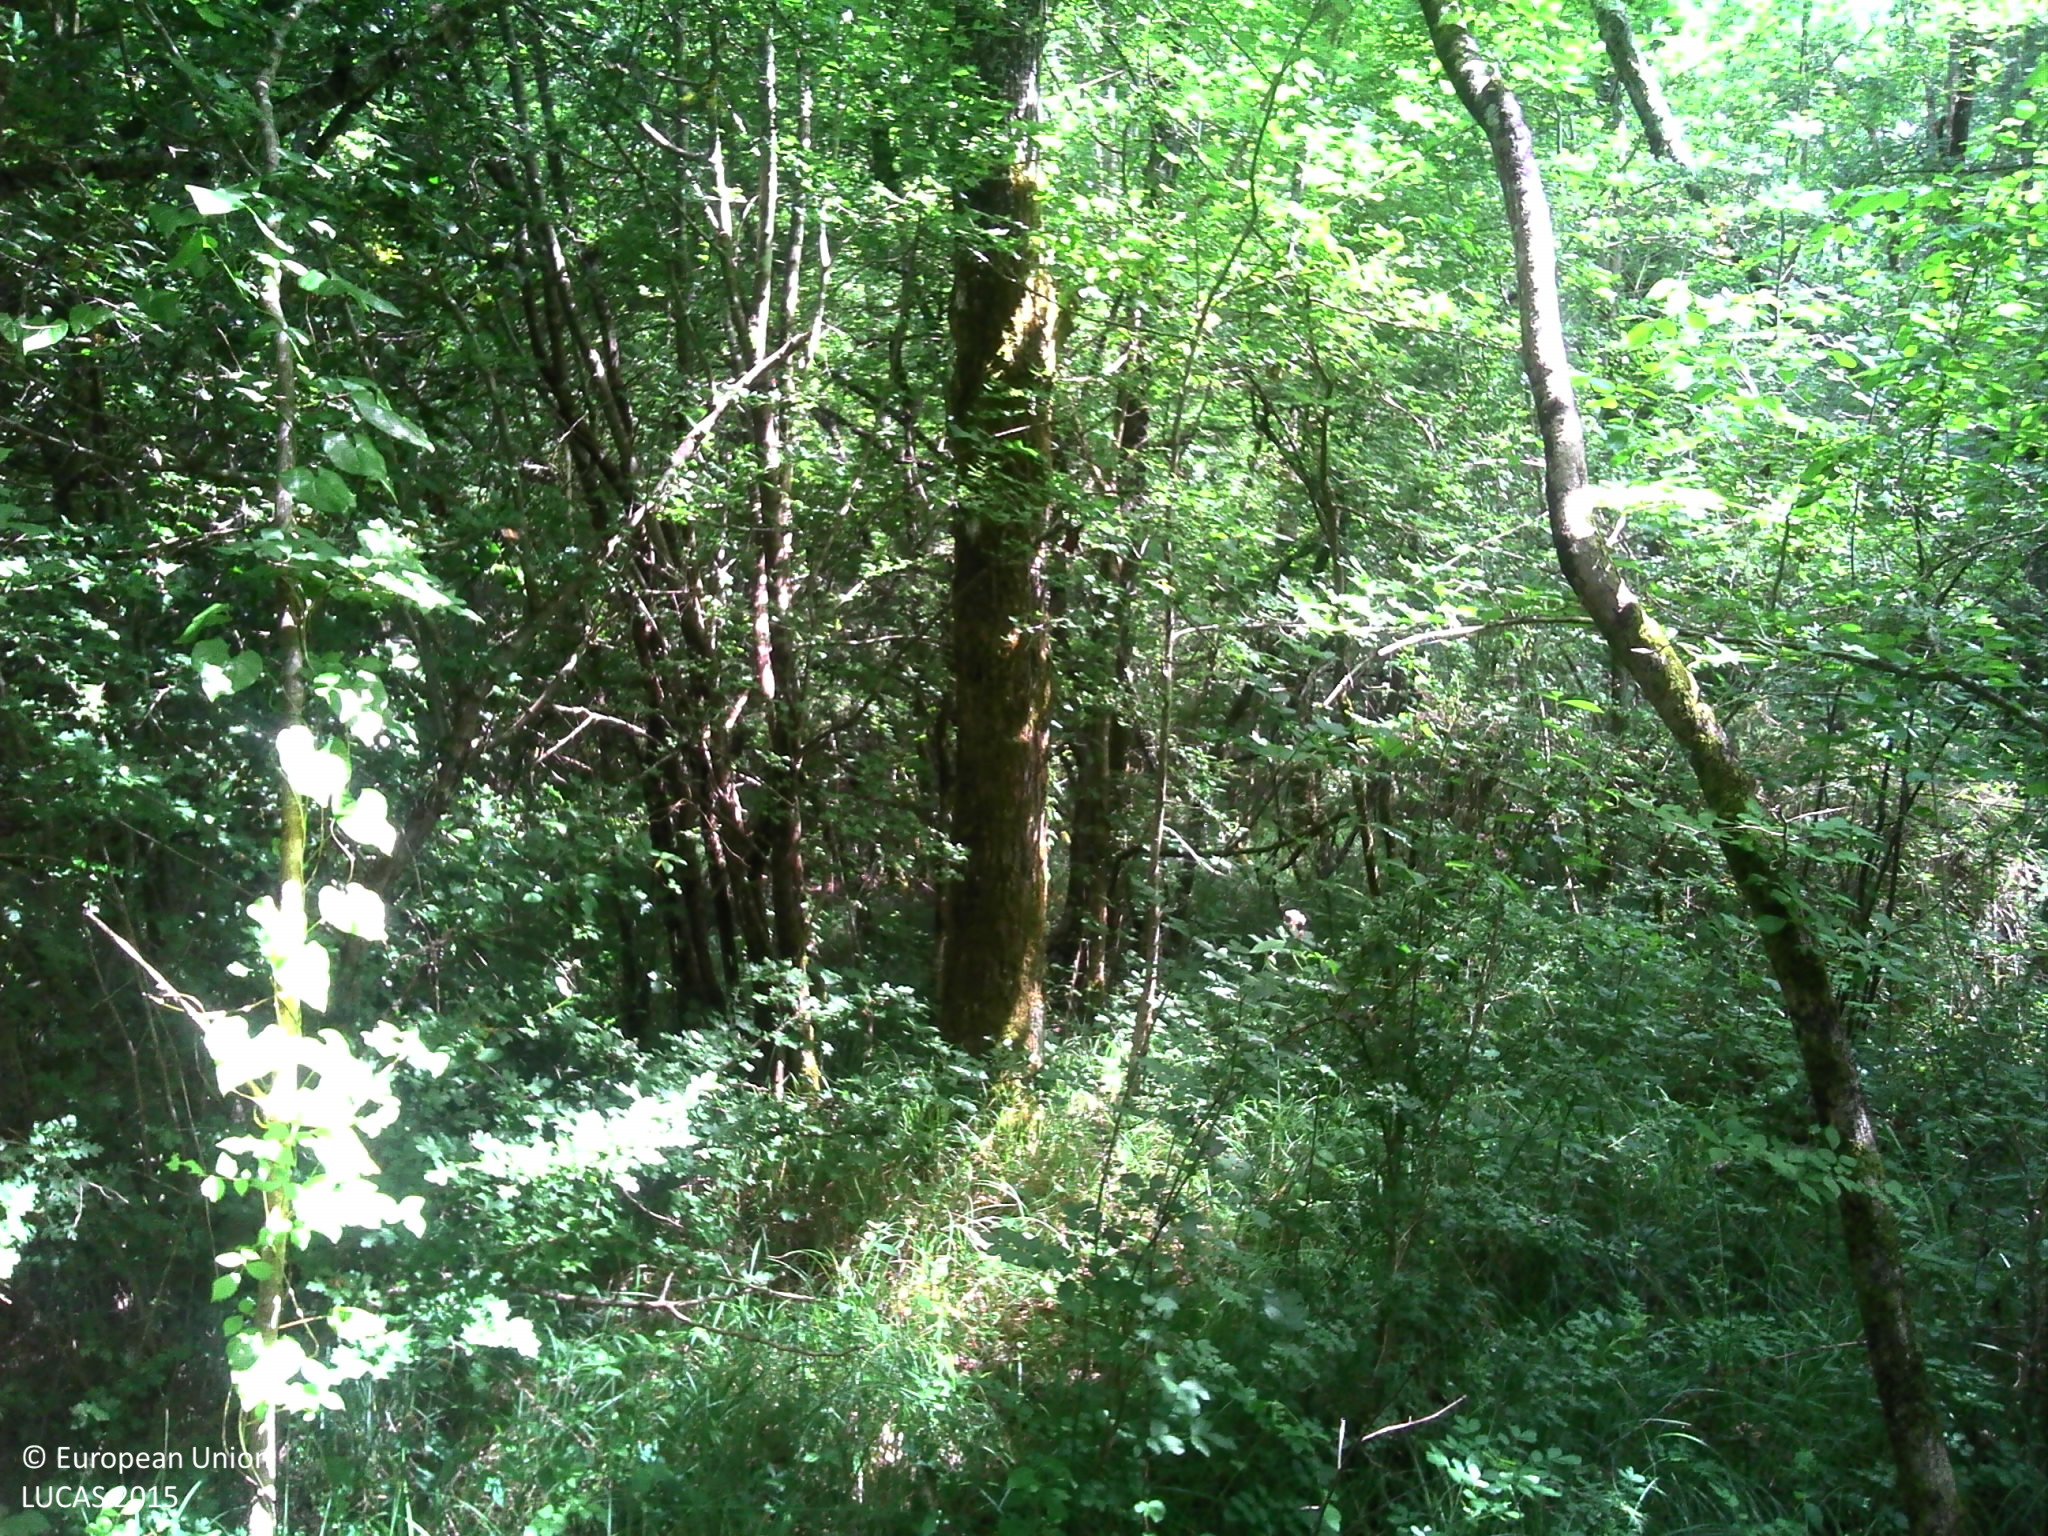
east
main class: Woodland
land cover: Broadleaved woodland
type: mesophytic deciduous forest
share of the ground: > 75 %
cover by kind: broadleaved forest trees 80 %, herbaceous plants 15 %, shrubs 5 %
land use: Forestry
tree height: > 5 m
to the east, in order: Broadleaved woodland; Fences; Grassland without tree/shrub cover; Paved roads, cycling and walking lanes; Durum wheat; Abandoned hedges; Fences; Grassland without tree/shrub cover; Broadleaved woodland
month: June
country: FR
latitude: 45.7927
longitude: -0.8976
